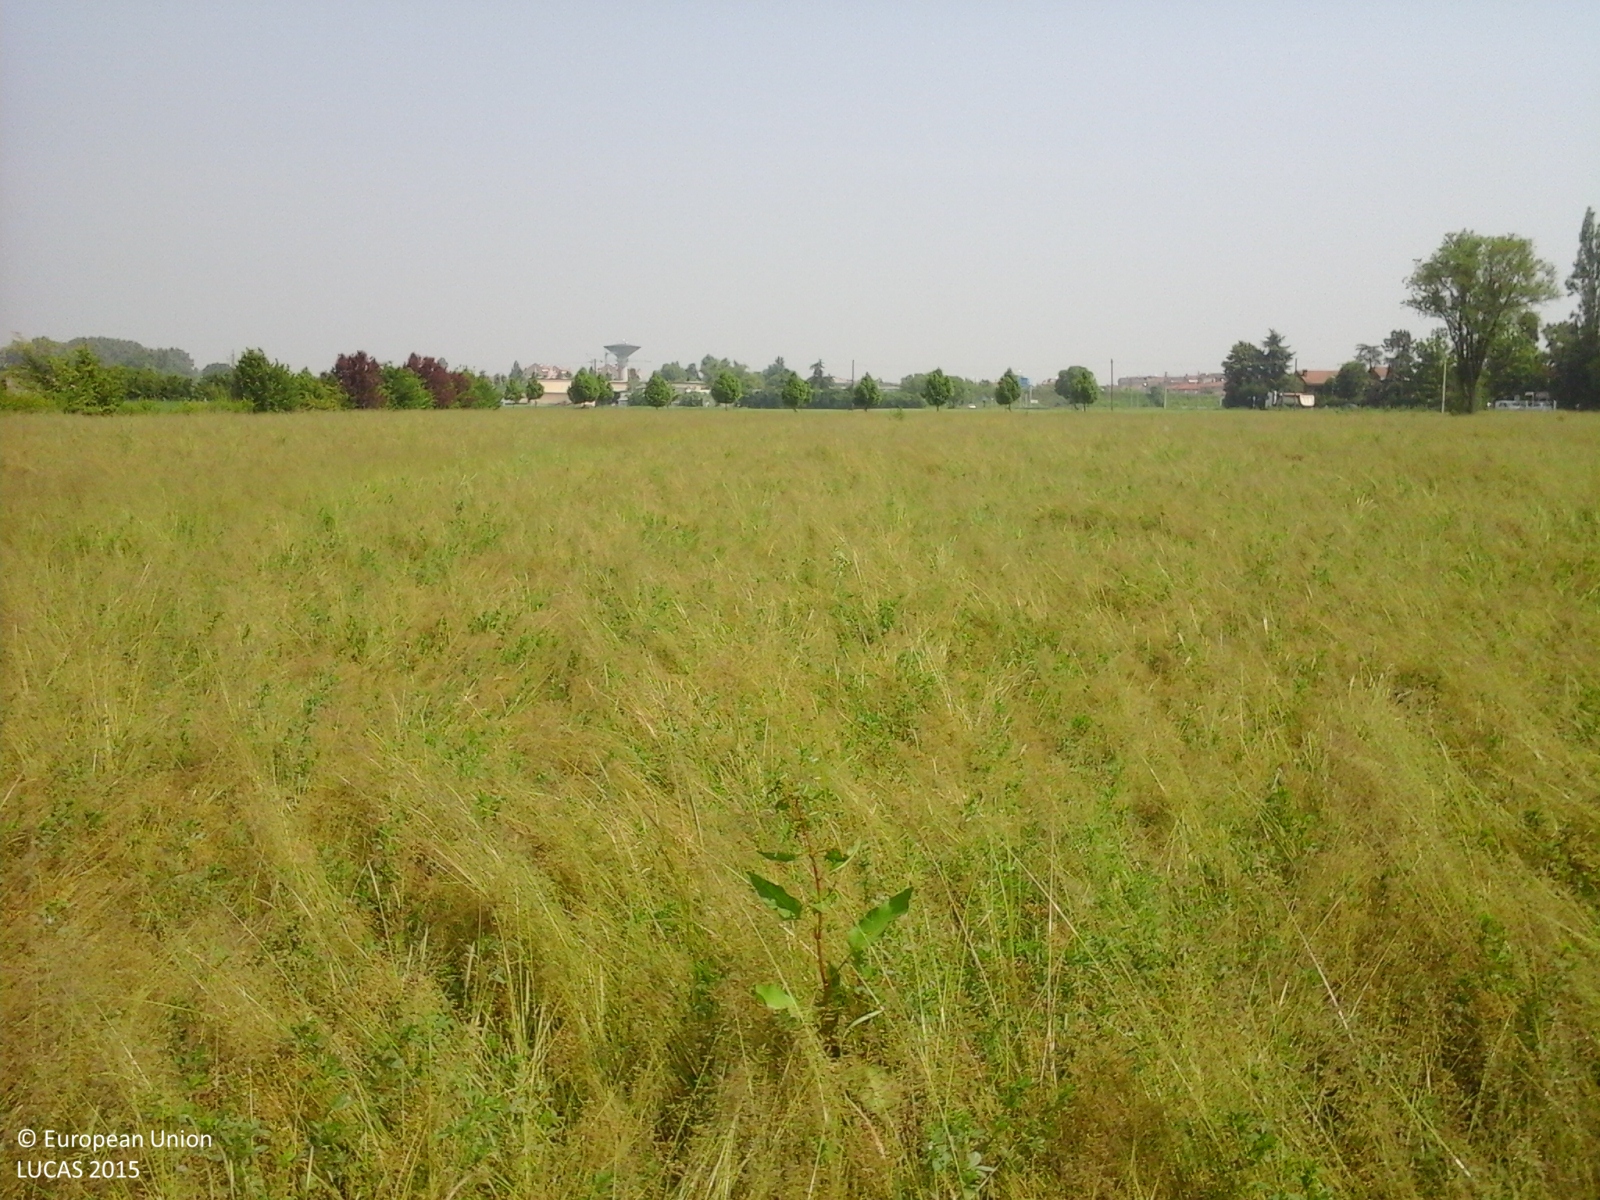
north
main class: Cropland
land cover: Lucerne
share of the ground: > 75 %
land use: Agriculture (excluding fallow land and kitchen gardens)
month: May
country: IT
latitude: 44.5798
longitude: 11.0431
